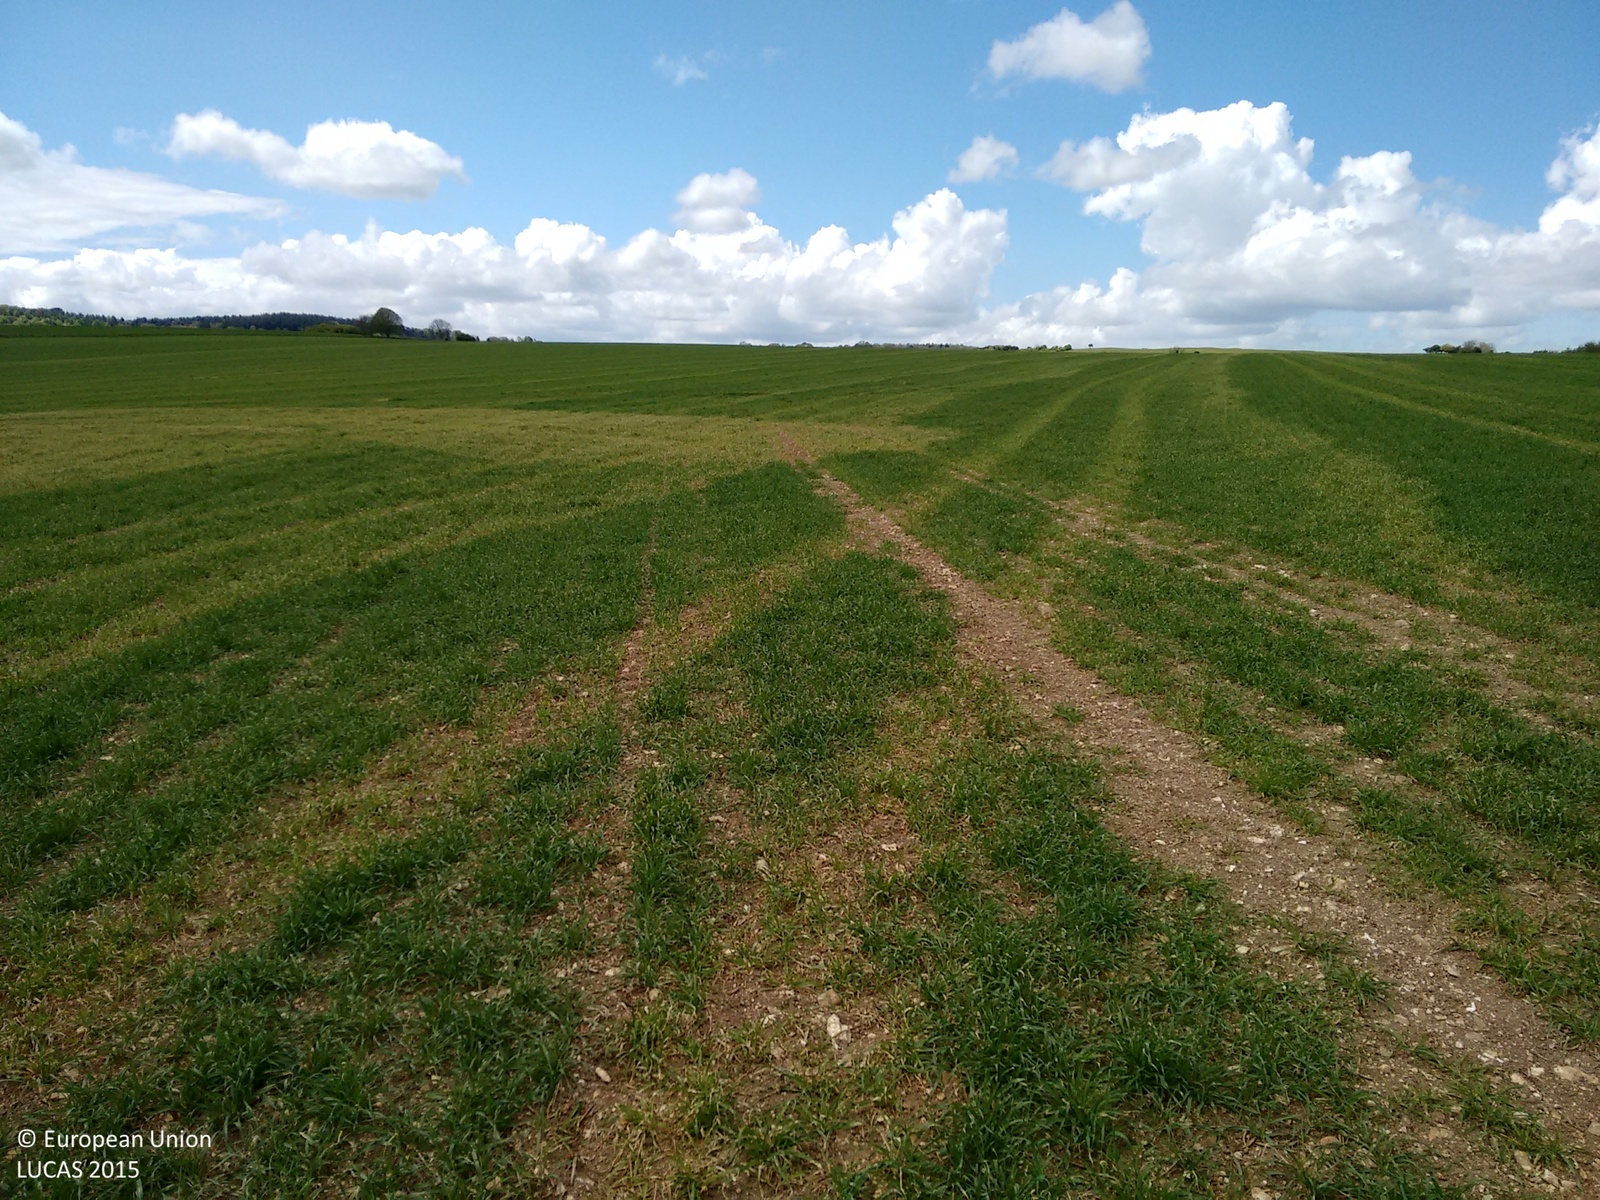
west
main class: Cropland
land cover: Barley
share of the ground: 50 - 75 %
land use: Agriculture (excluding fallow land and kitchen gardens)
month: April
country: GB
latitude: 50.9595
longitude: -1.8878
